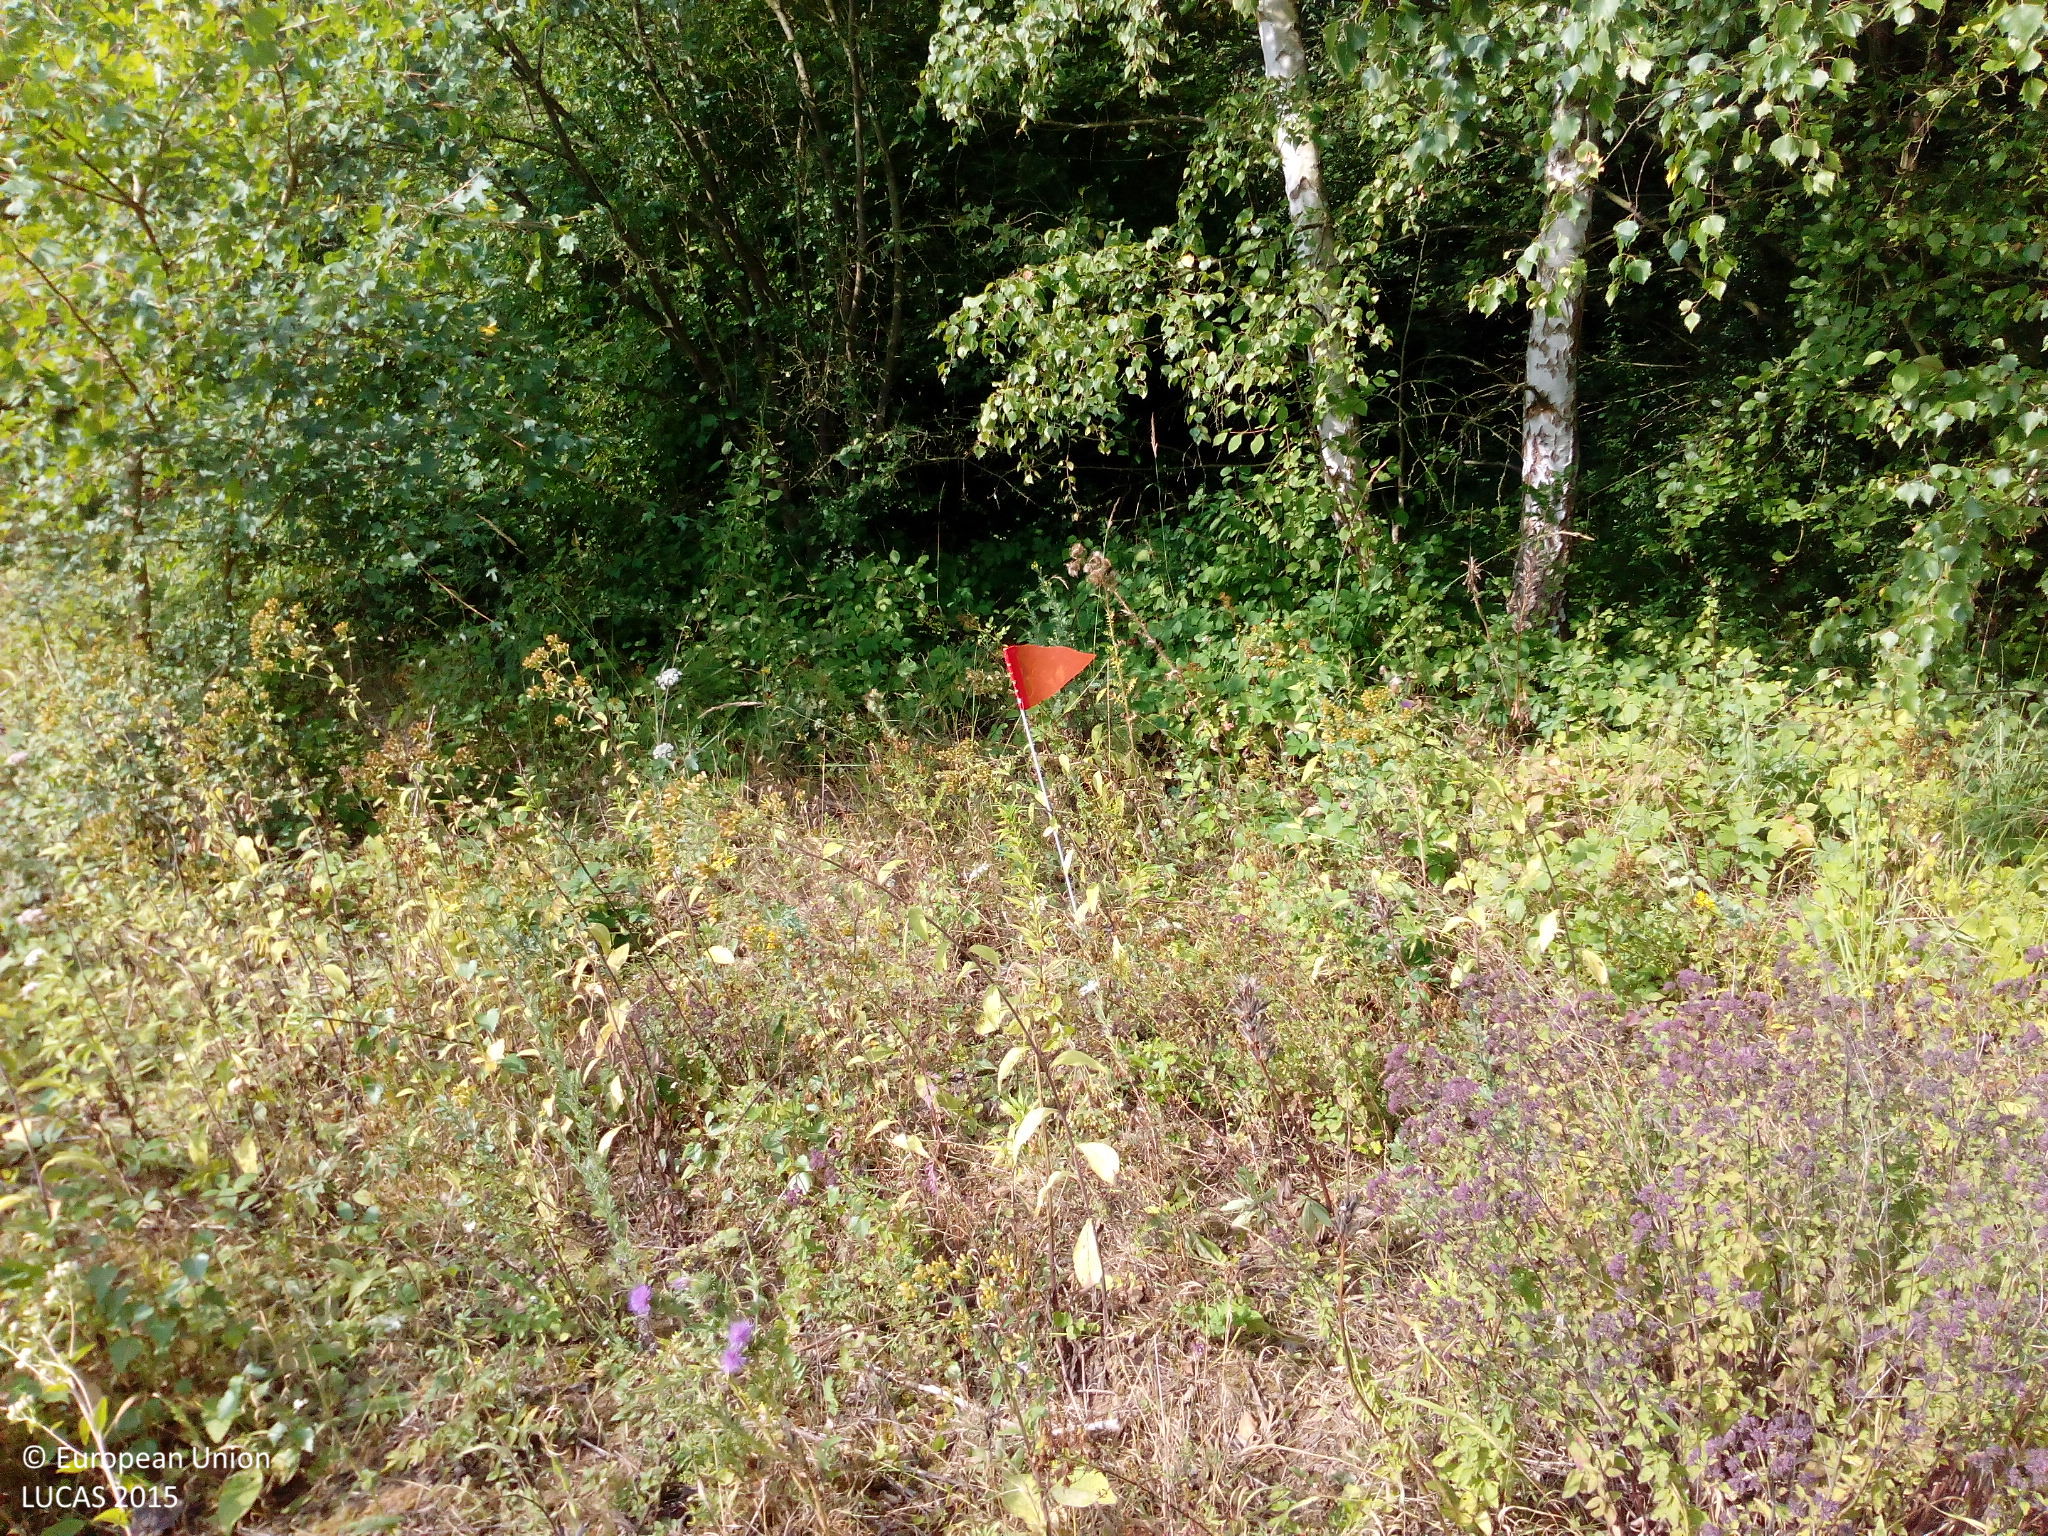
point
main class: Woodland
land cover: Broadleaved woodland
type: acidophilous oak and oak-birch forest
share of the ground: 25 - 50 %
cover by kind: herbaceous plants 50 %, broadleaved forest trees 40 %, shrubs 10 %
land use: Semi-natural and natural areas not in use
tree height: > 5 m
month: August
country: DE
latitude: 50.3370
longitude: 7.5134
